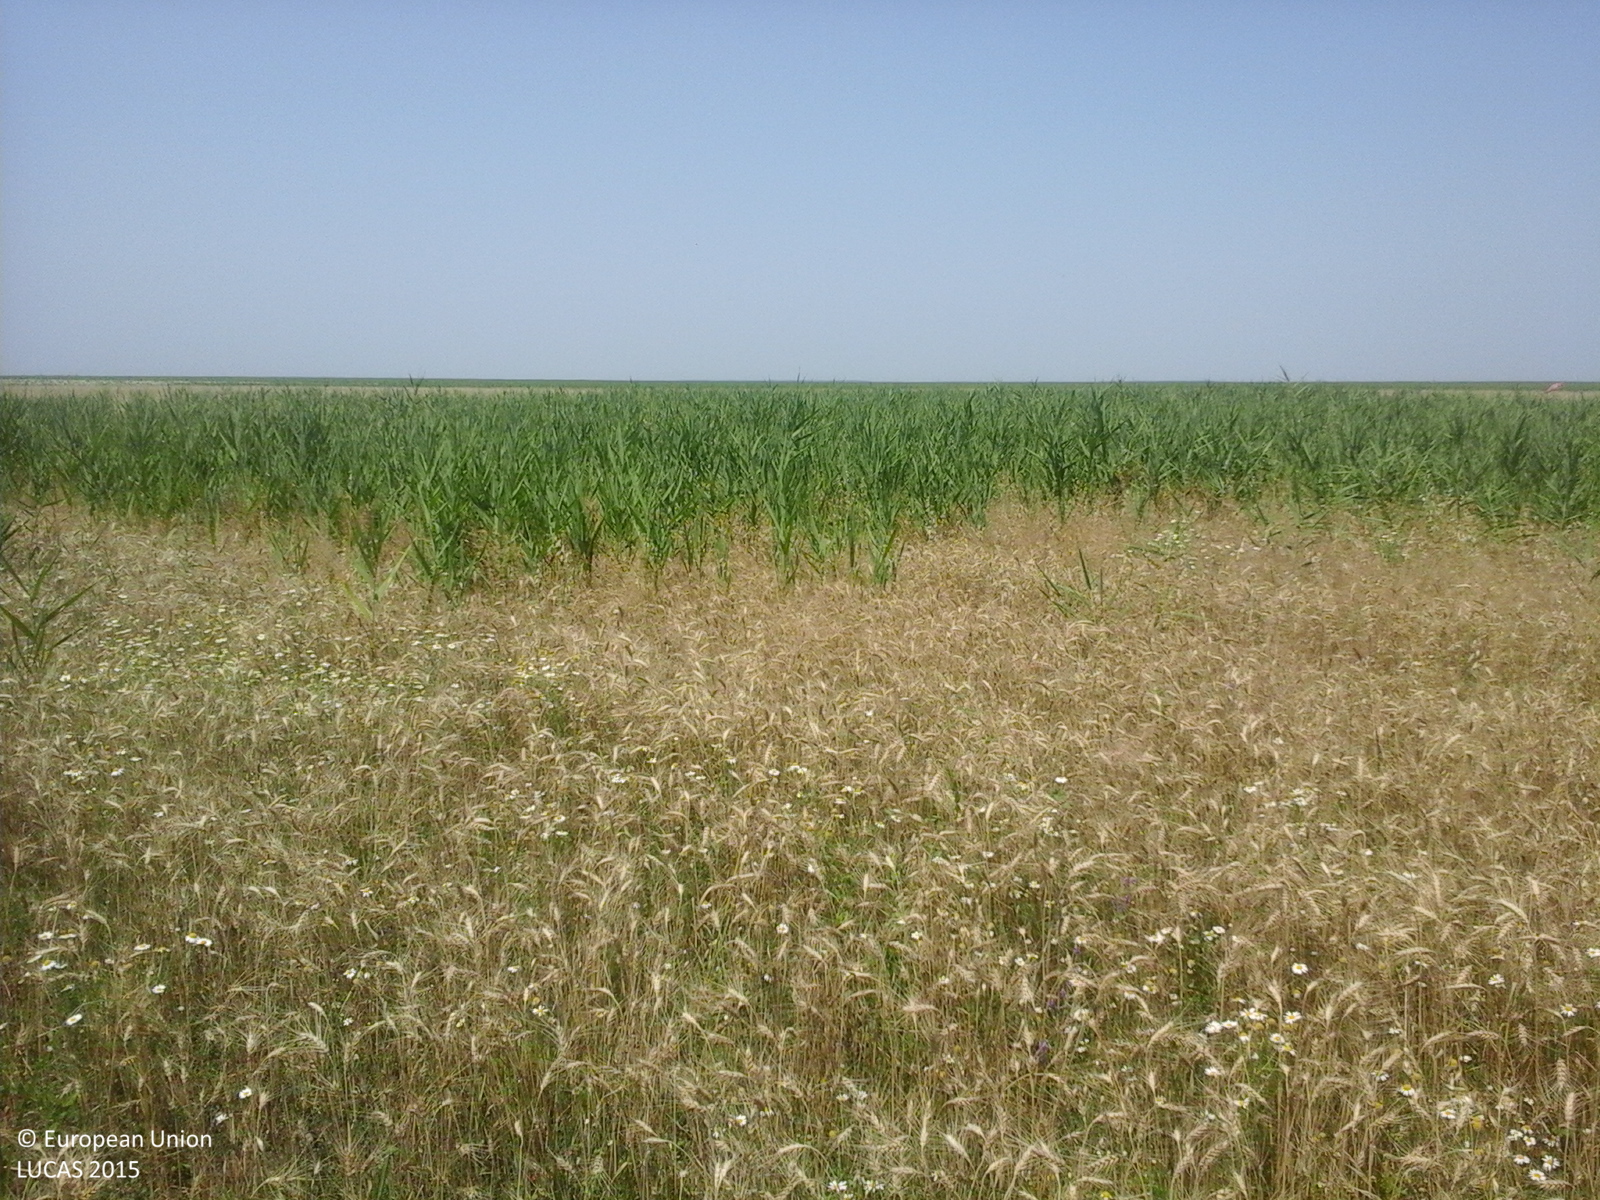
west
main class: Cropland
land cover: Mixed cereals for fodder
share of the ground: > 75 %
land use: Agriculture (excluding fallow land and kitchen gardens)
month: July
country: RO
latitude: 44.4587
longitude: 24.8963
